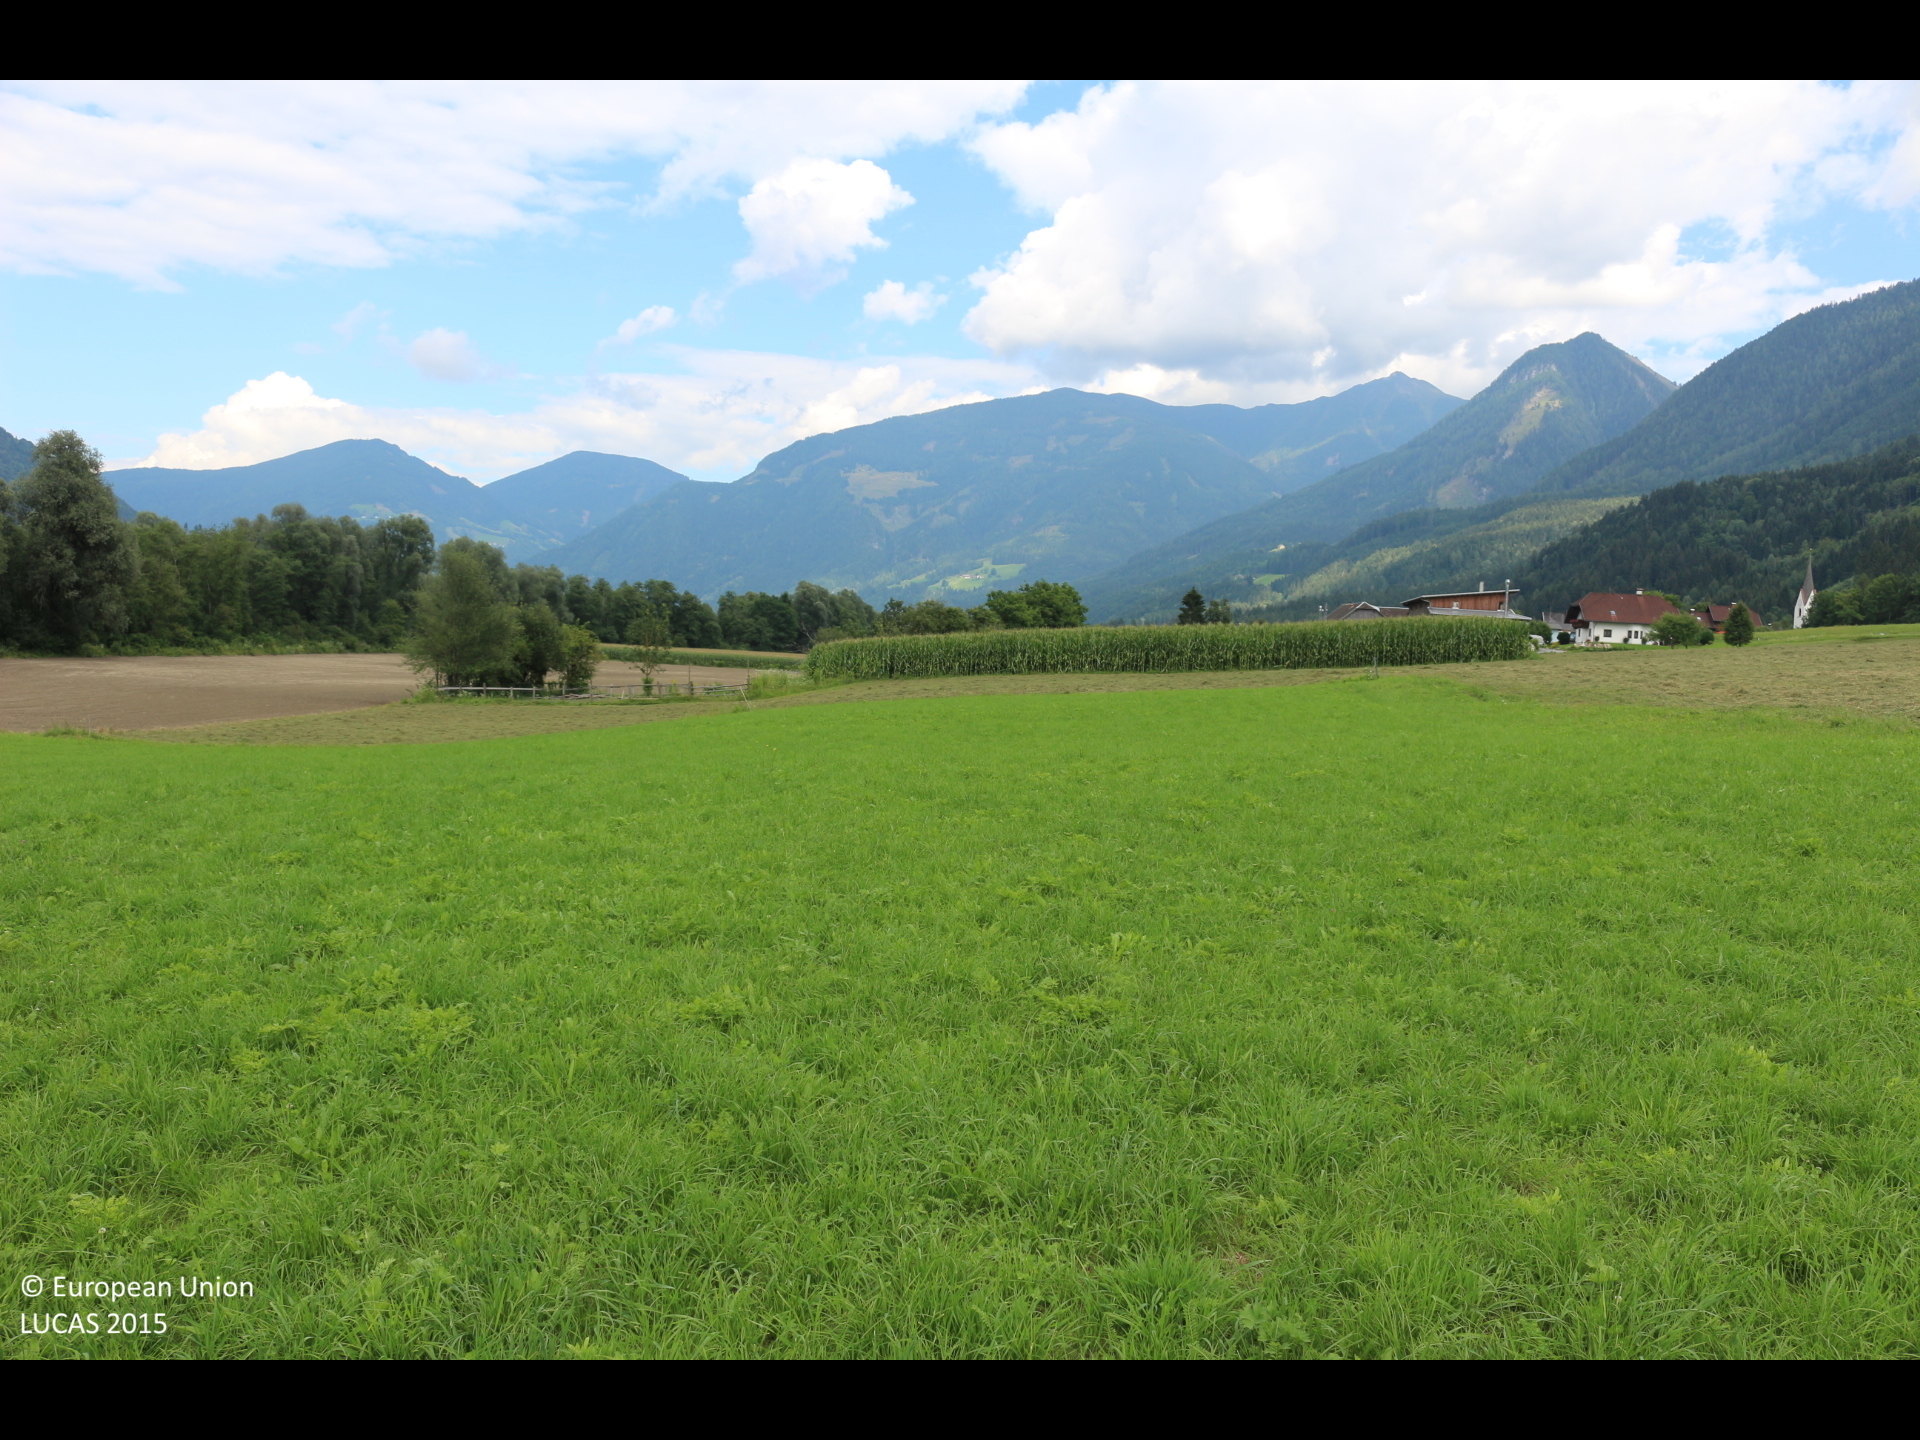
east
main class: Grassland
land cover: Grassland without tree/shrub cover
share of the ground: > 75 %
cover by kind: herbaceous plants 100 %
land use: Agriculture (excluding fallow land and kitchen gardens)
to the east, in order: Grassland without tree/shrub cover; Maize
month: August
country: AT
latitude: 46.7514
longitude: 13.2831
